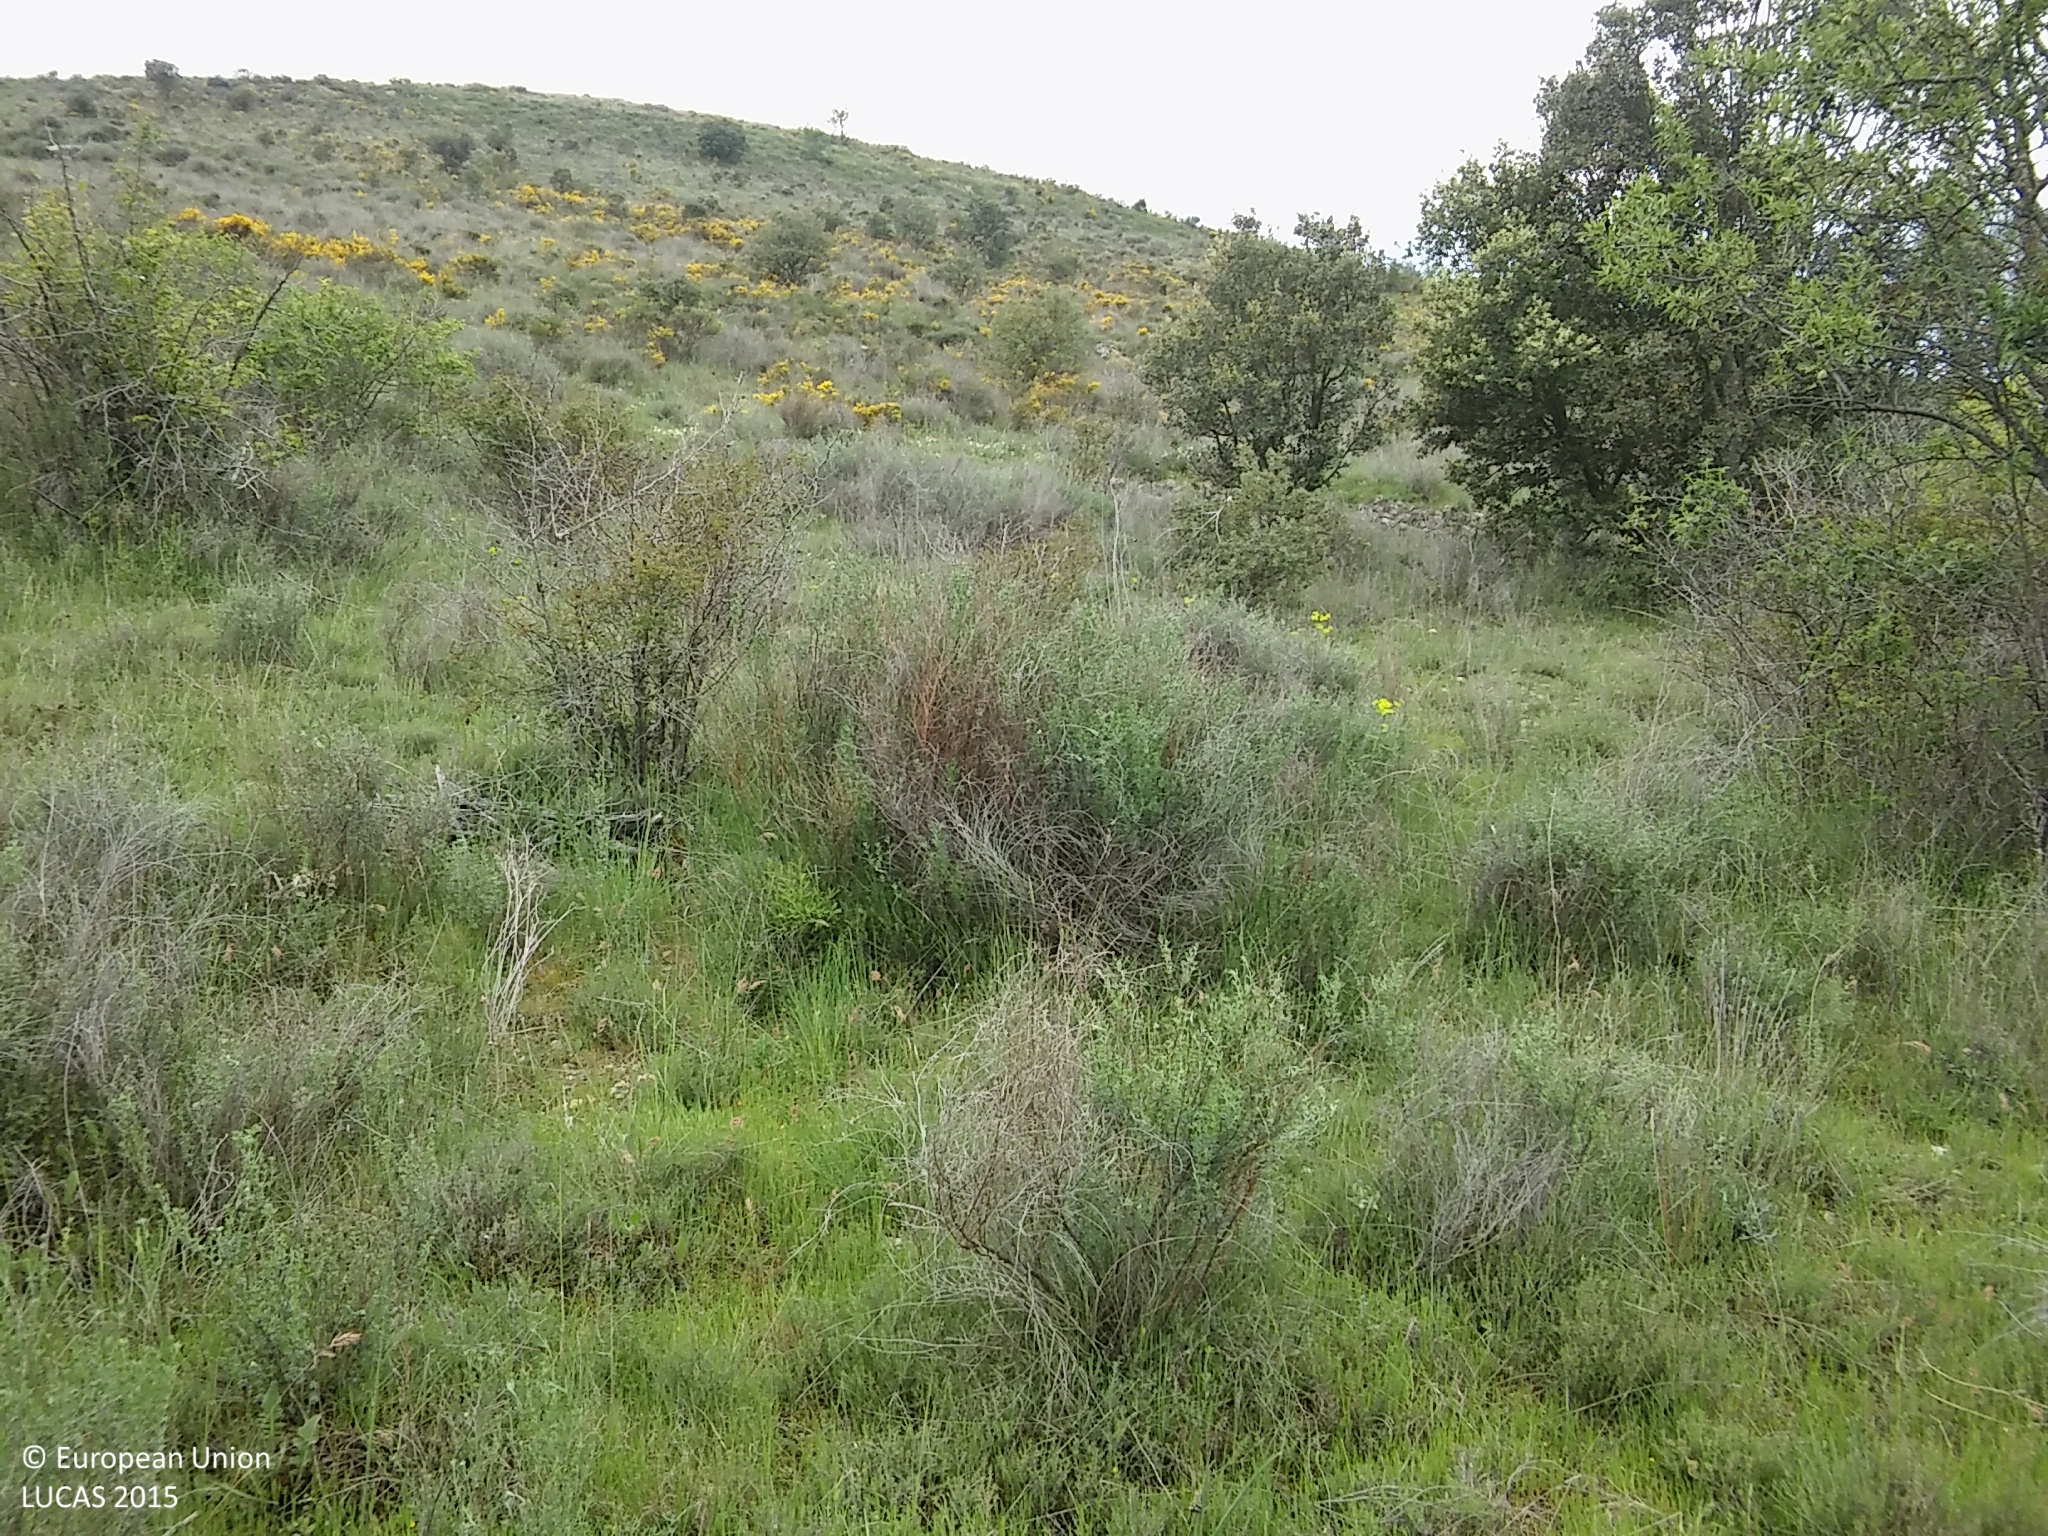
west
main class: Shrubland
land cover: Shrubland with sparse tree cover
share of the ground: 25 - 50 %
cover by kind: herbaceous plants 55 %, shrubs 30 %, unconsolidated bare surface 10 %, broadleaved forest trees 5 %
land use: Semi-natural and natural areas not in use
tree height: > 5 m
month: May
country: ES
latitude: 41.4242
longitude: -3.9699
